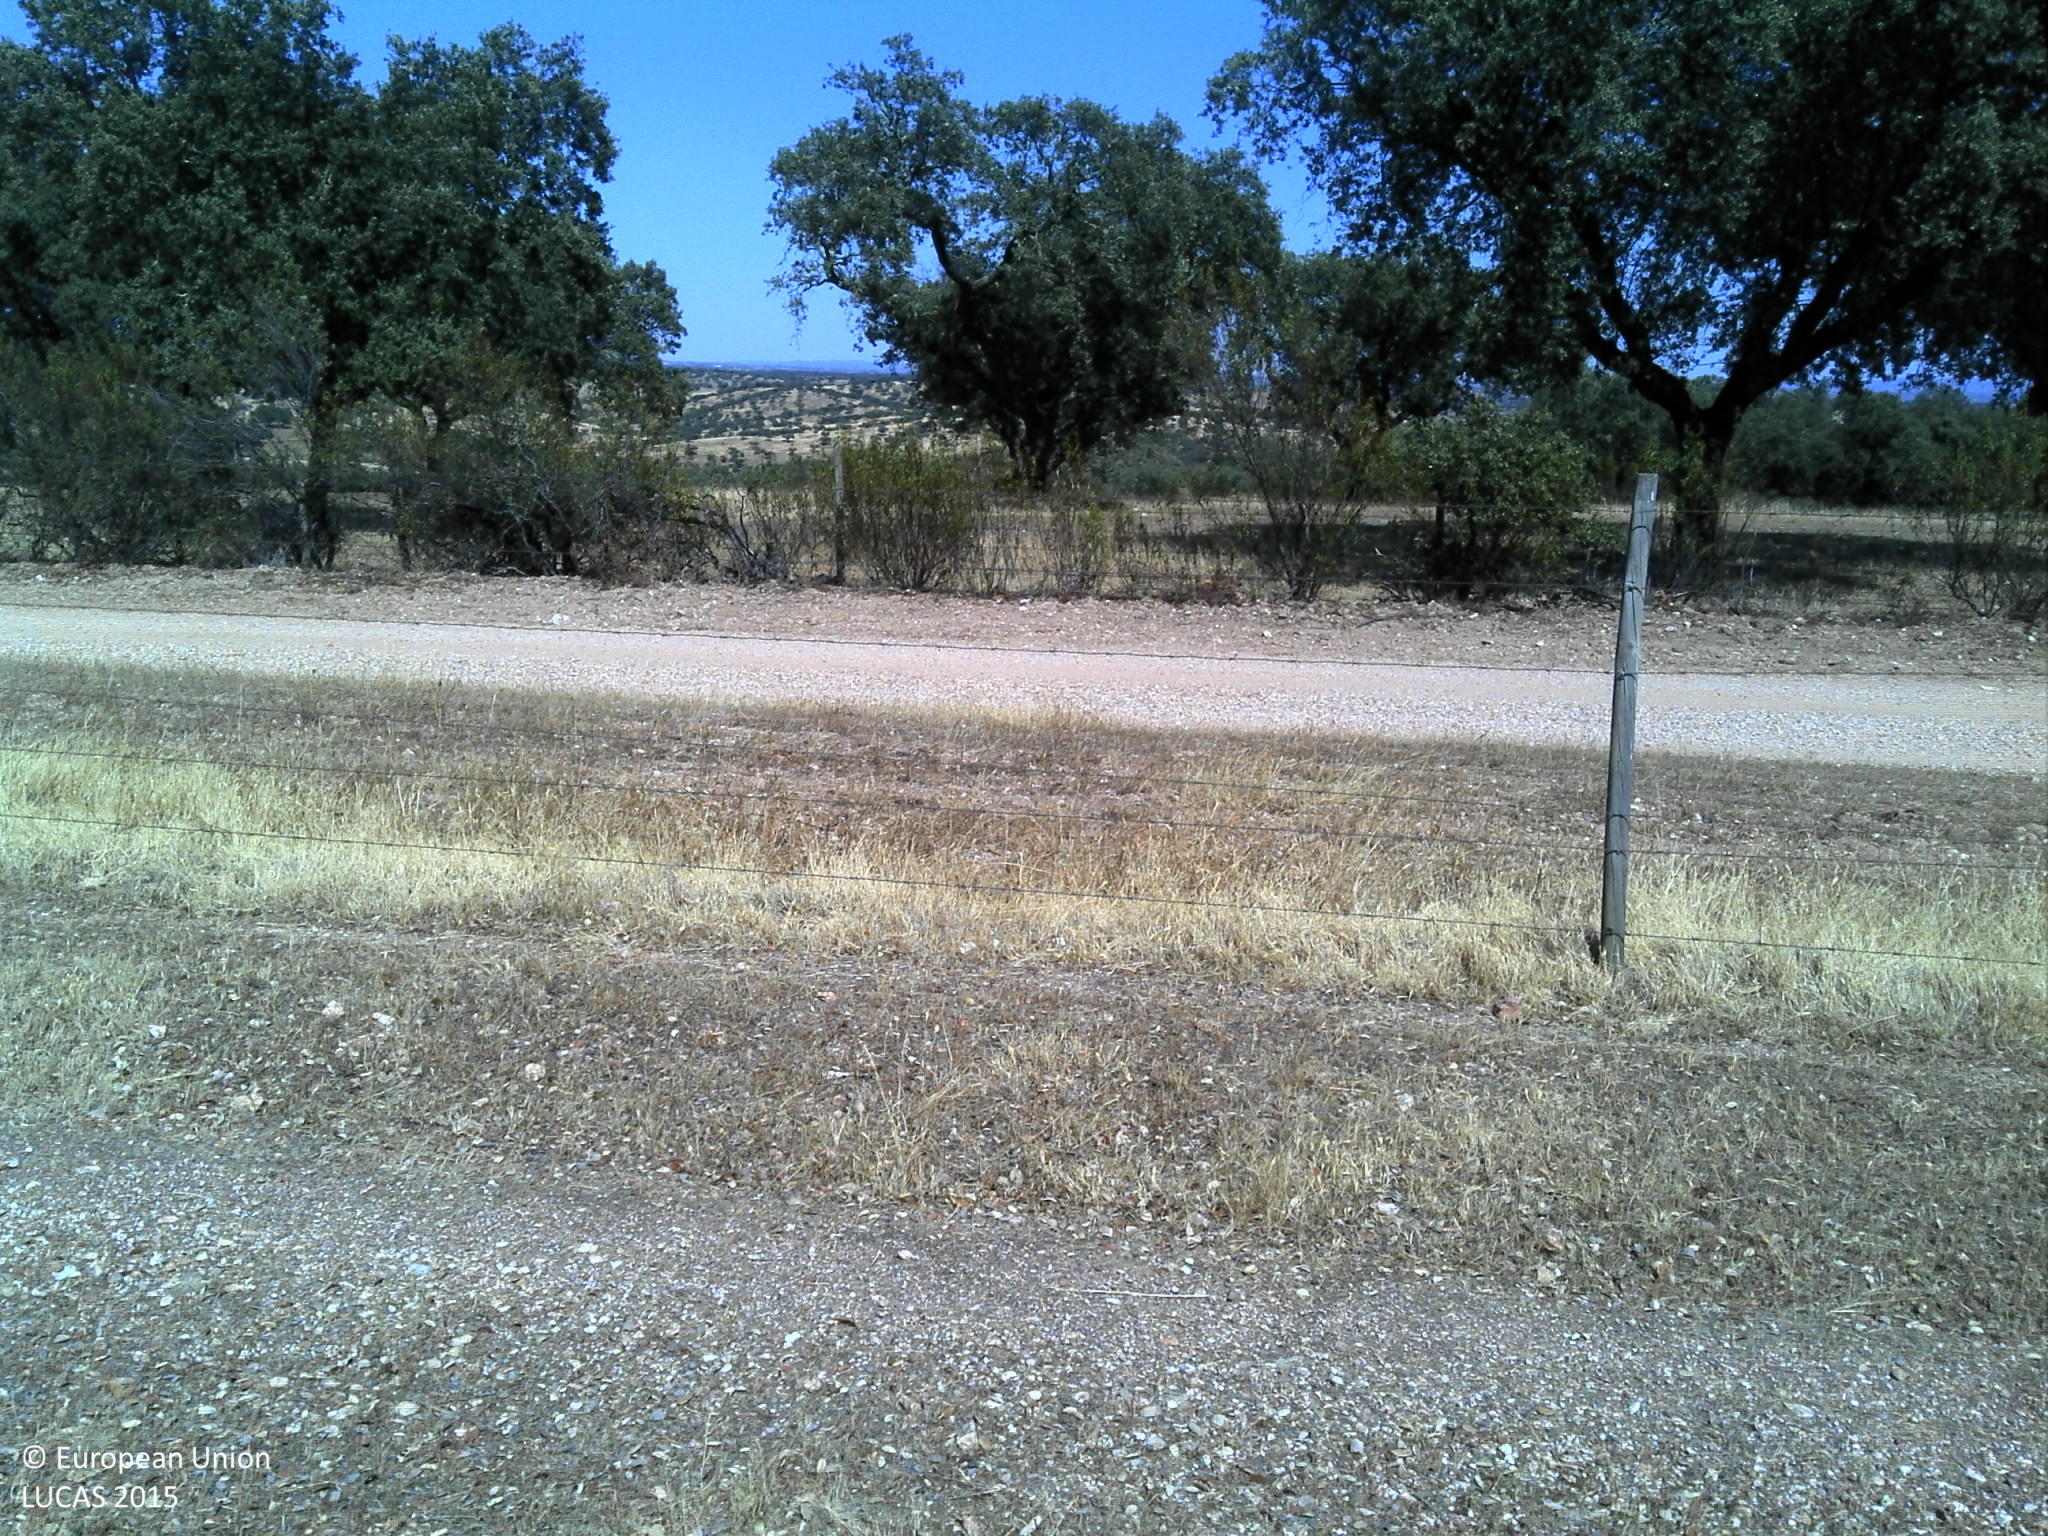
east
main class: Woodland
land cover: Broadleaved woodland
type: broadleaved evergreen forest
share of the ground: 25 - 50 %
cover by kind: broadleaved forest trees 45 %, unconsolidated bare surface 35 %, herbaceous plants 20 %
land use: Forestry
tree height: > 5 m
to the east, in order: Broadleaved woodland; Fences; Grassland without tree/shrub cover; Tracks; Other bare soil; Shruby margins; Fences; Broadleaved woodland
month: July
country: PT
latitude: 38.1576
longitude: -7.3311
